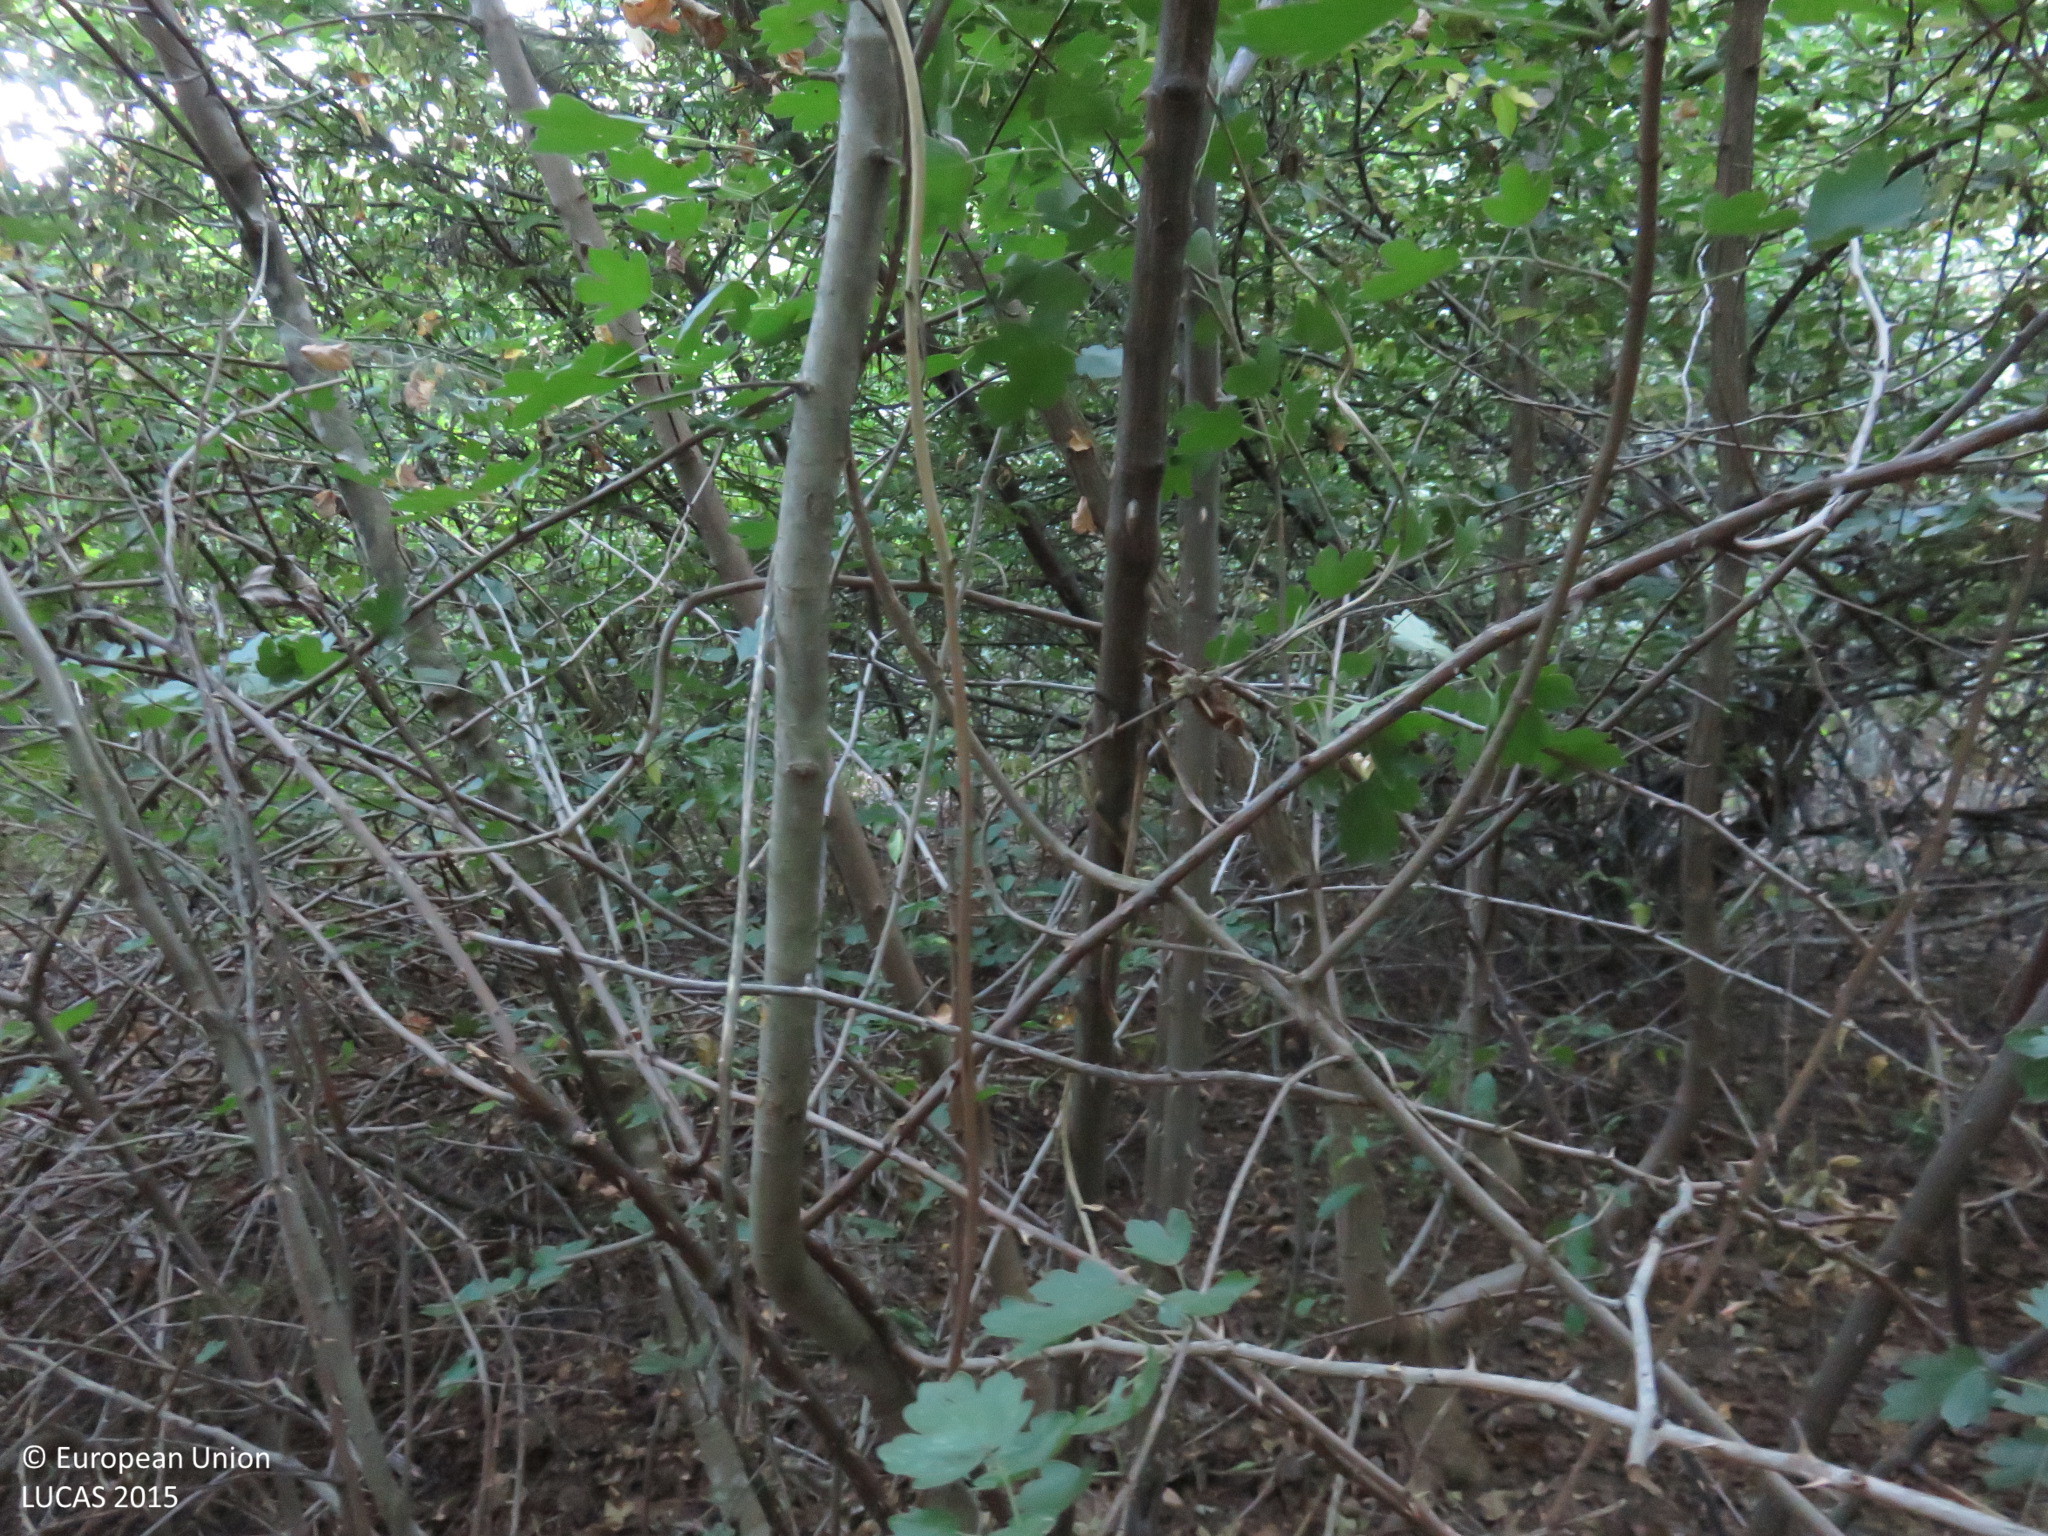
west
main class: Woodland
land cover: Broadleaved woodland
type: mesophytic deciduous forest
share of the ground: > 75 %
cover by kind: broadleaved forest trees 75 %, shrubs 25 %
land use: Forestry
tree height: < 5 m
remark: Clear cut
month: July
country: BG
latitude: 43.2438
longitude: 25.1833
